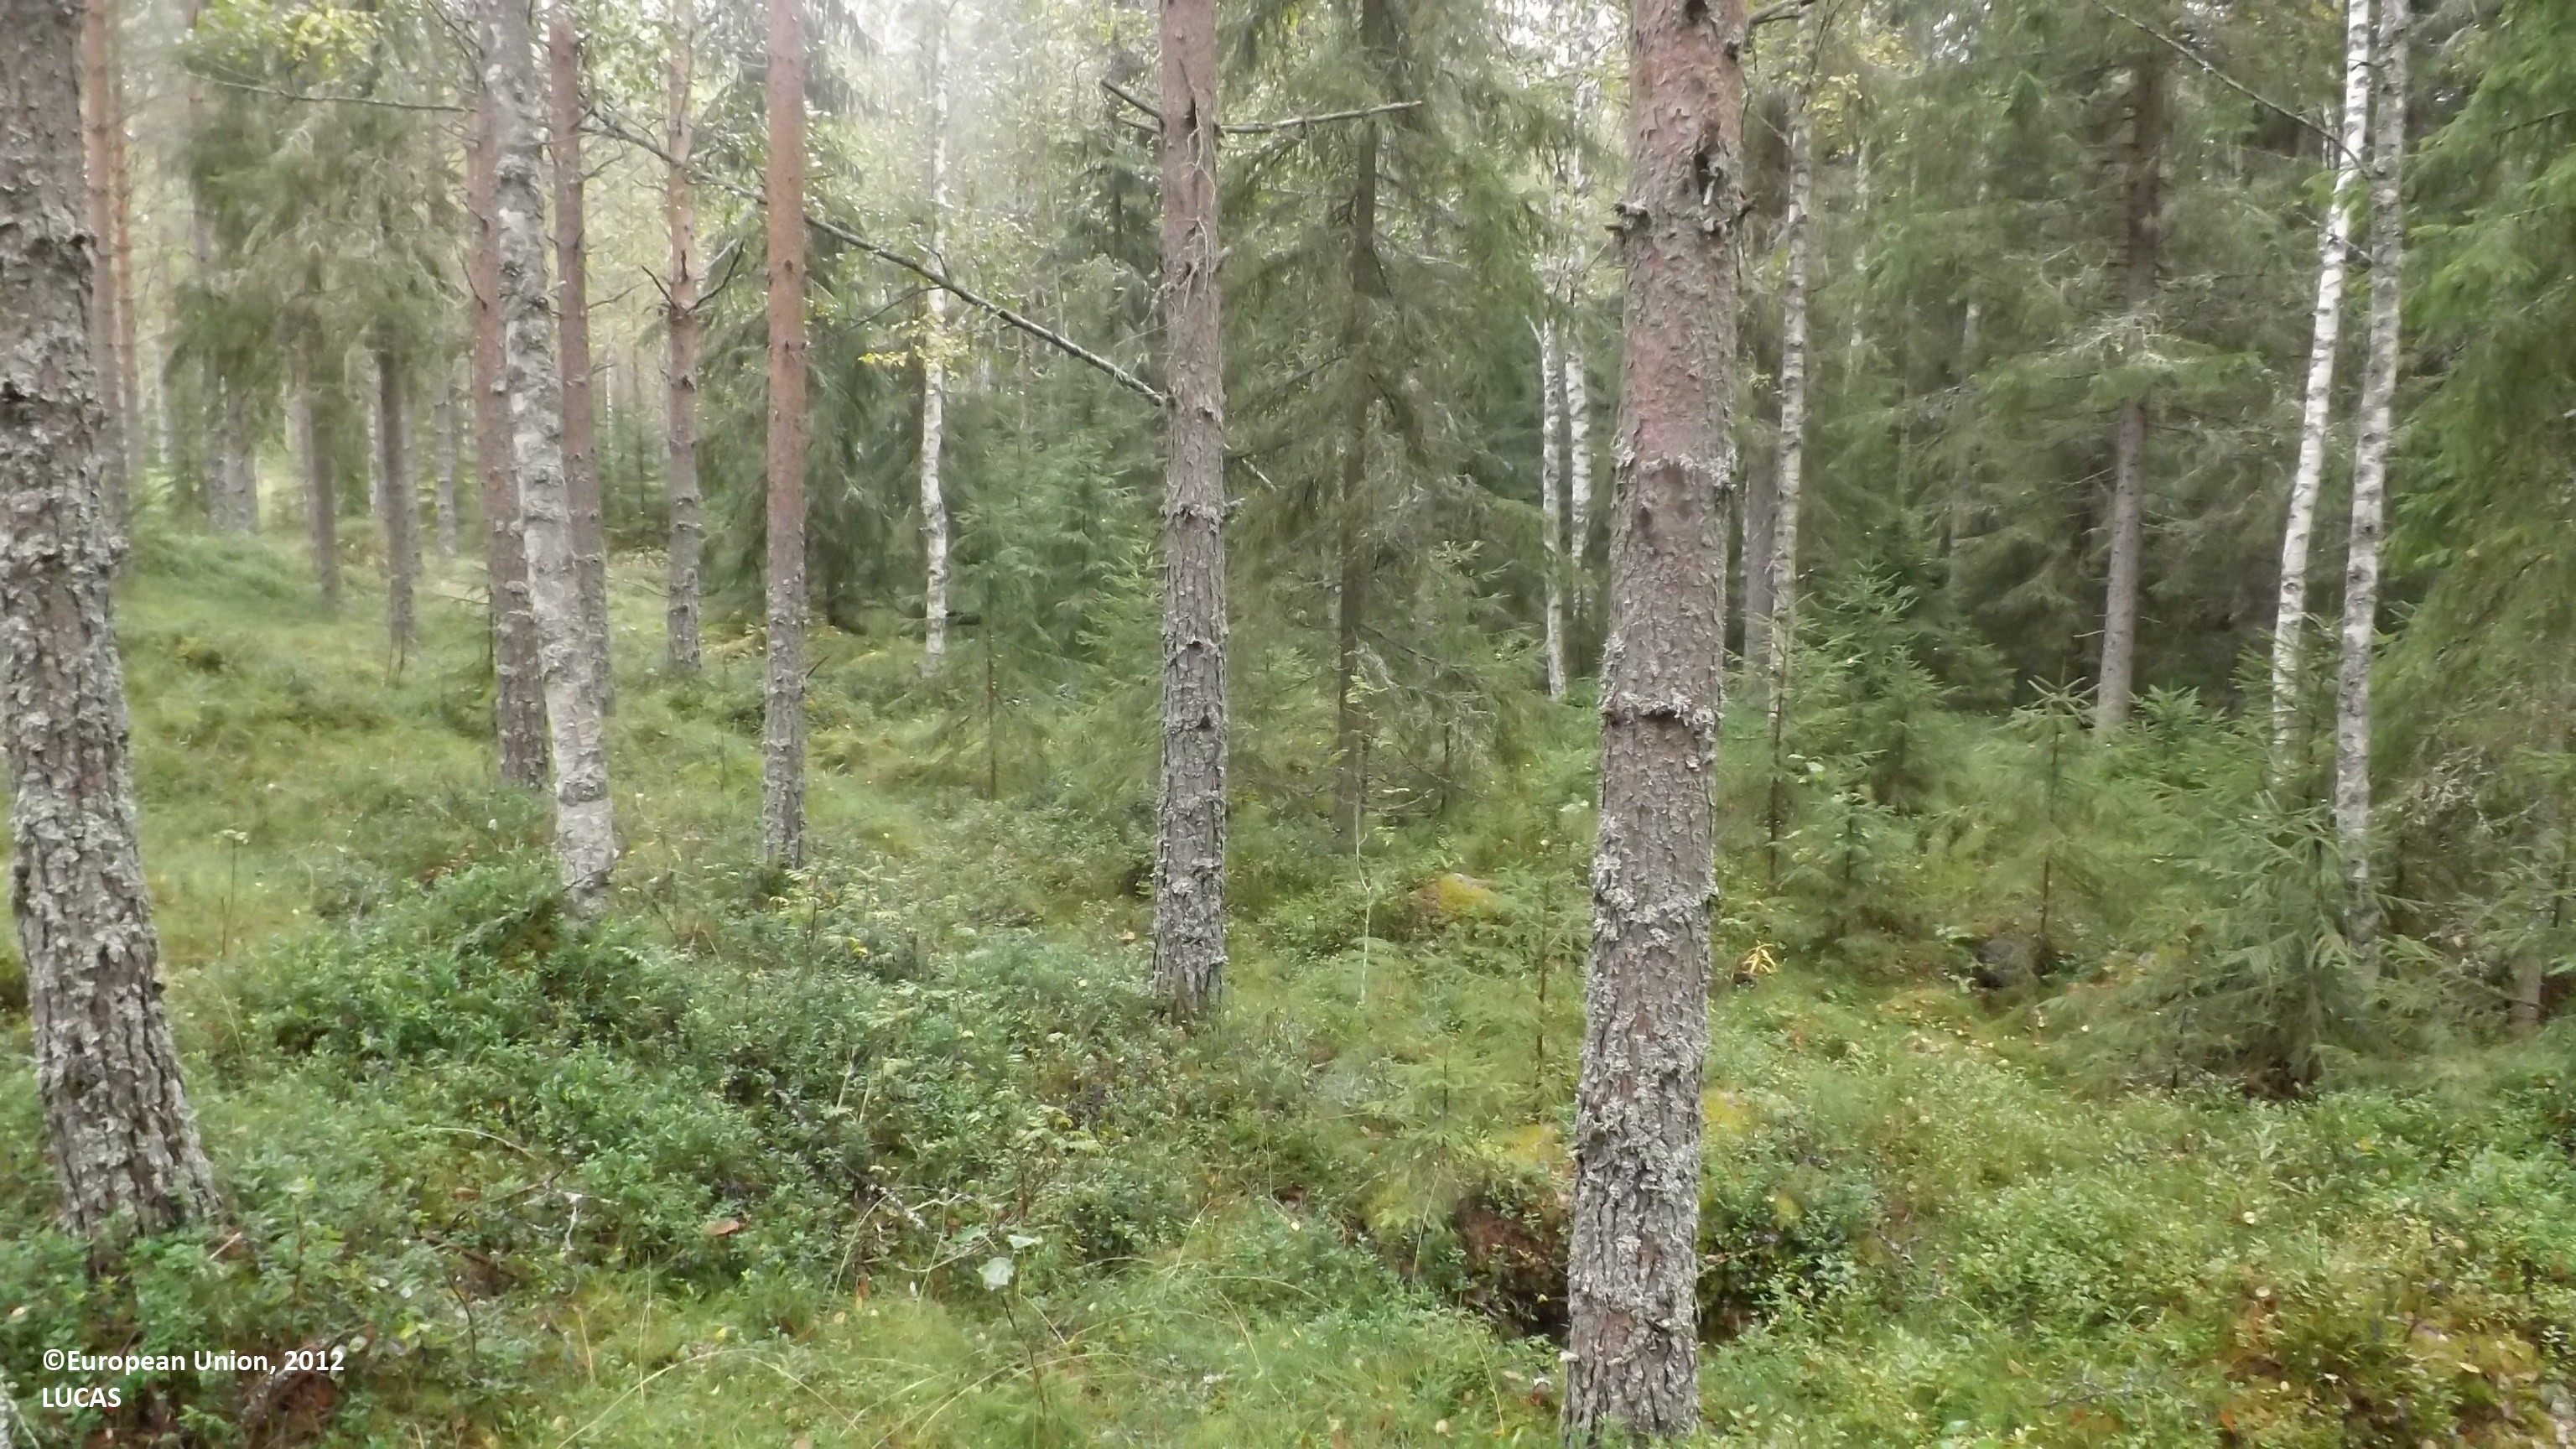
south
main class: Woodland
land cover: Other mixed woodland
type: boreal forest
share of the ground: 50 - 75 %
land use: Forestry
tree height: > 5 m
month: August
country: FI
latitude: 63.7770
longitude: 23.5492
